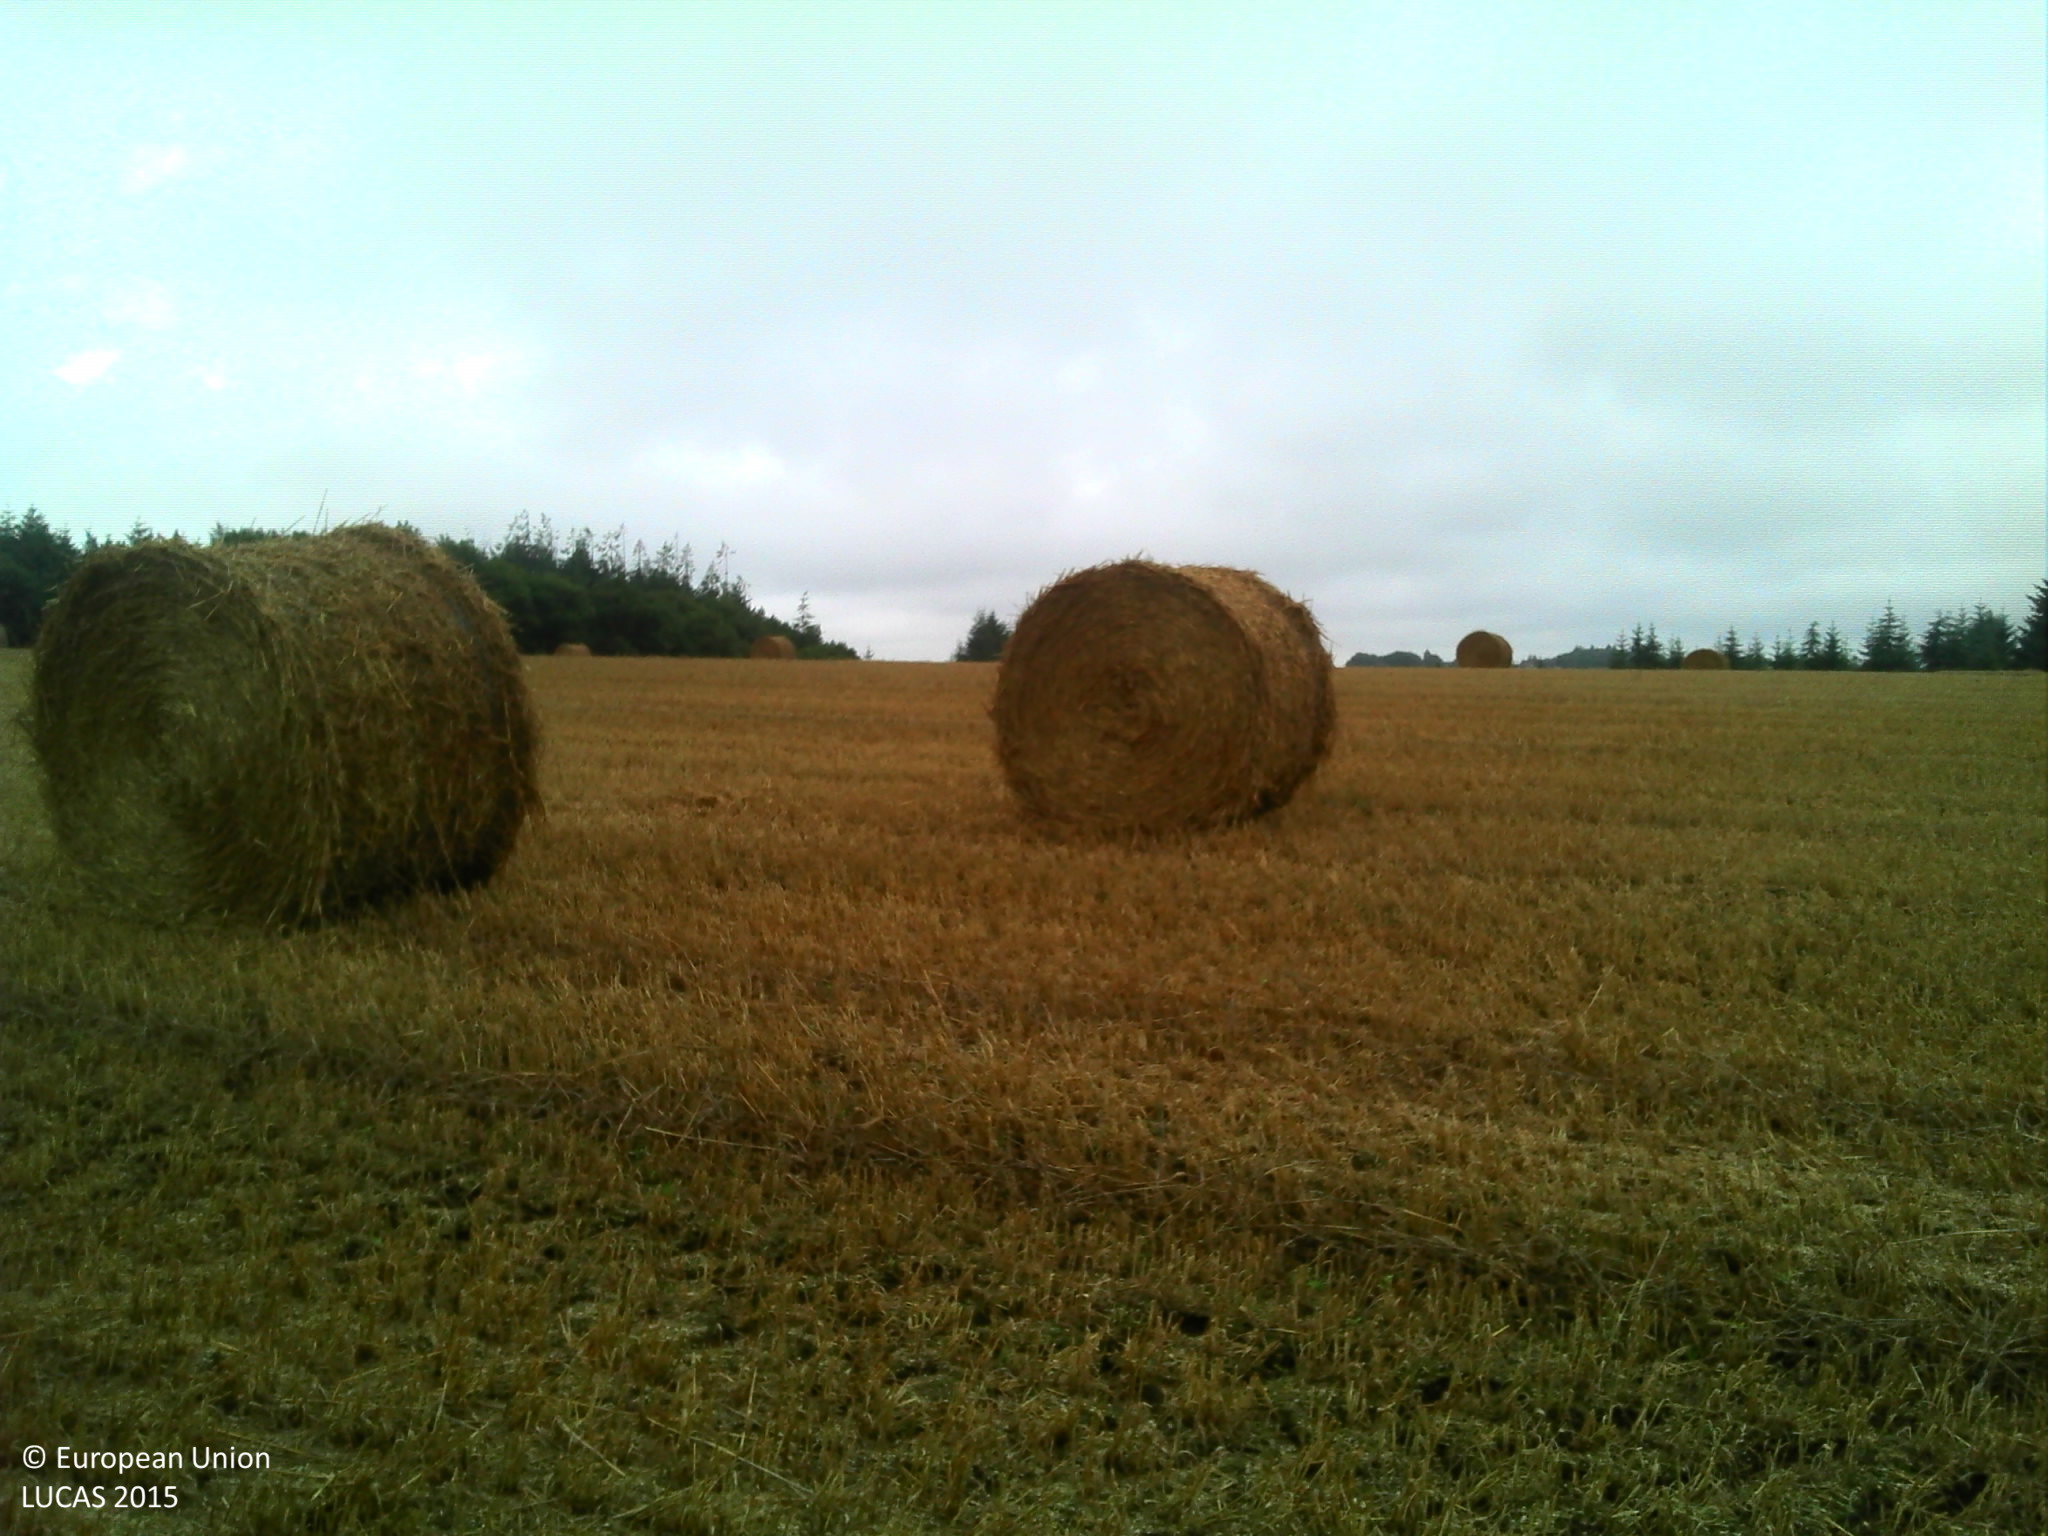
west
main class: Cropland
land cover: Common wheat
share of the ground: 50 - 75 %
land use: Agriculture (excluding fallow land and kitchen gardens)
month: August
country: FR
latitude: 48.3436
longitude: -3.1459
